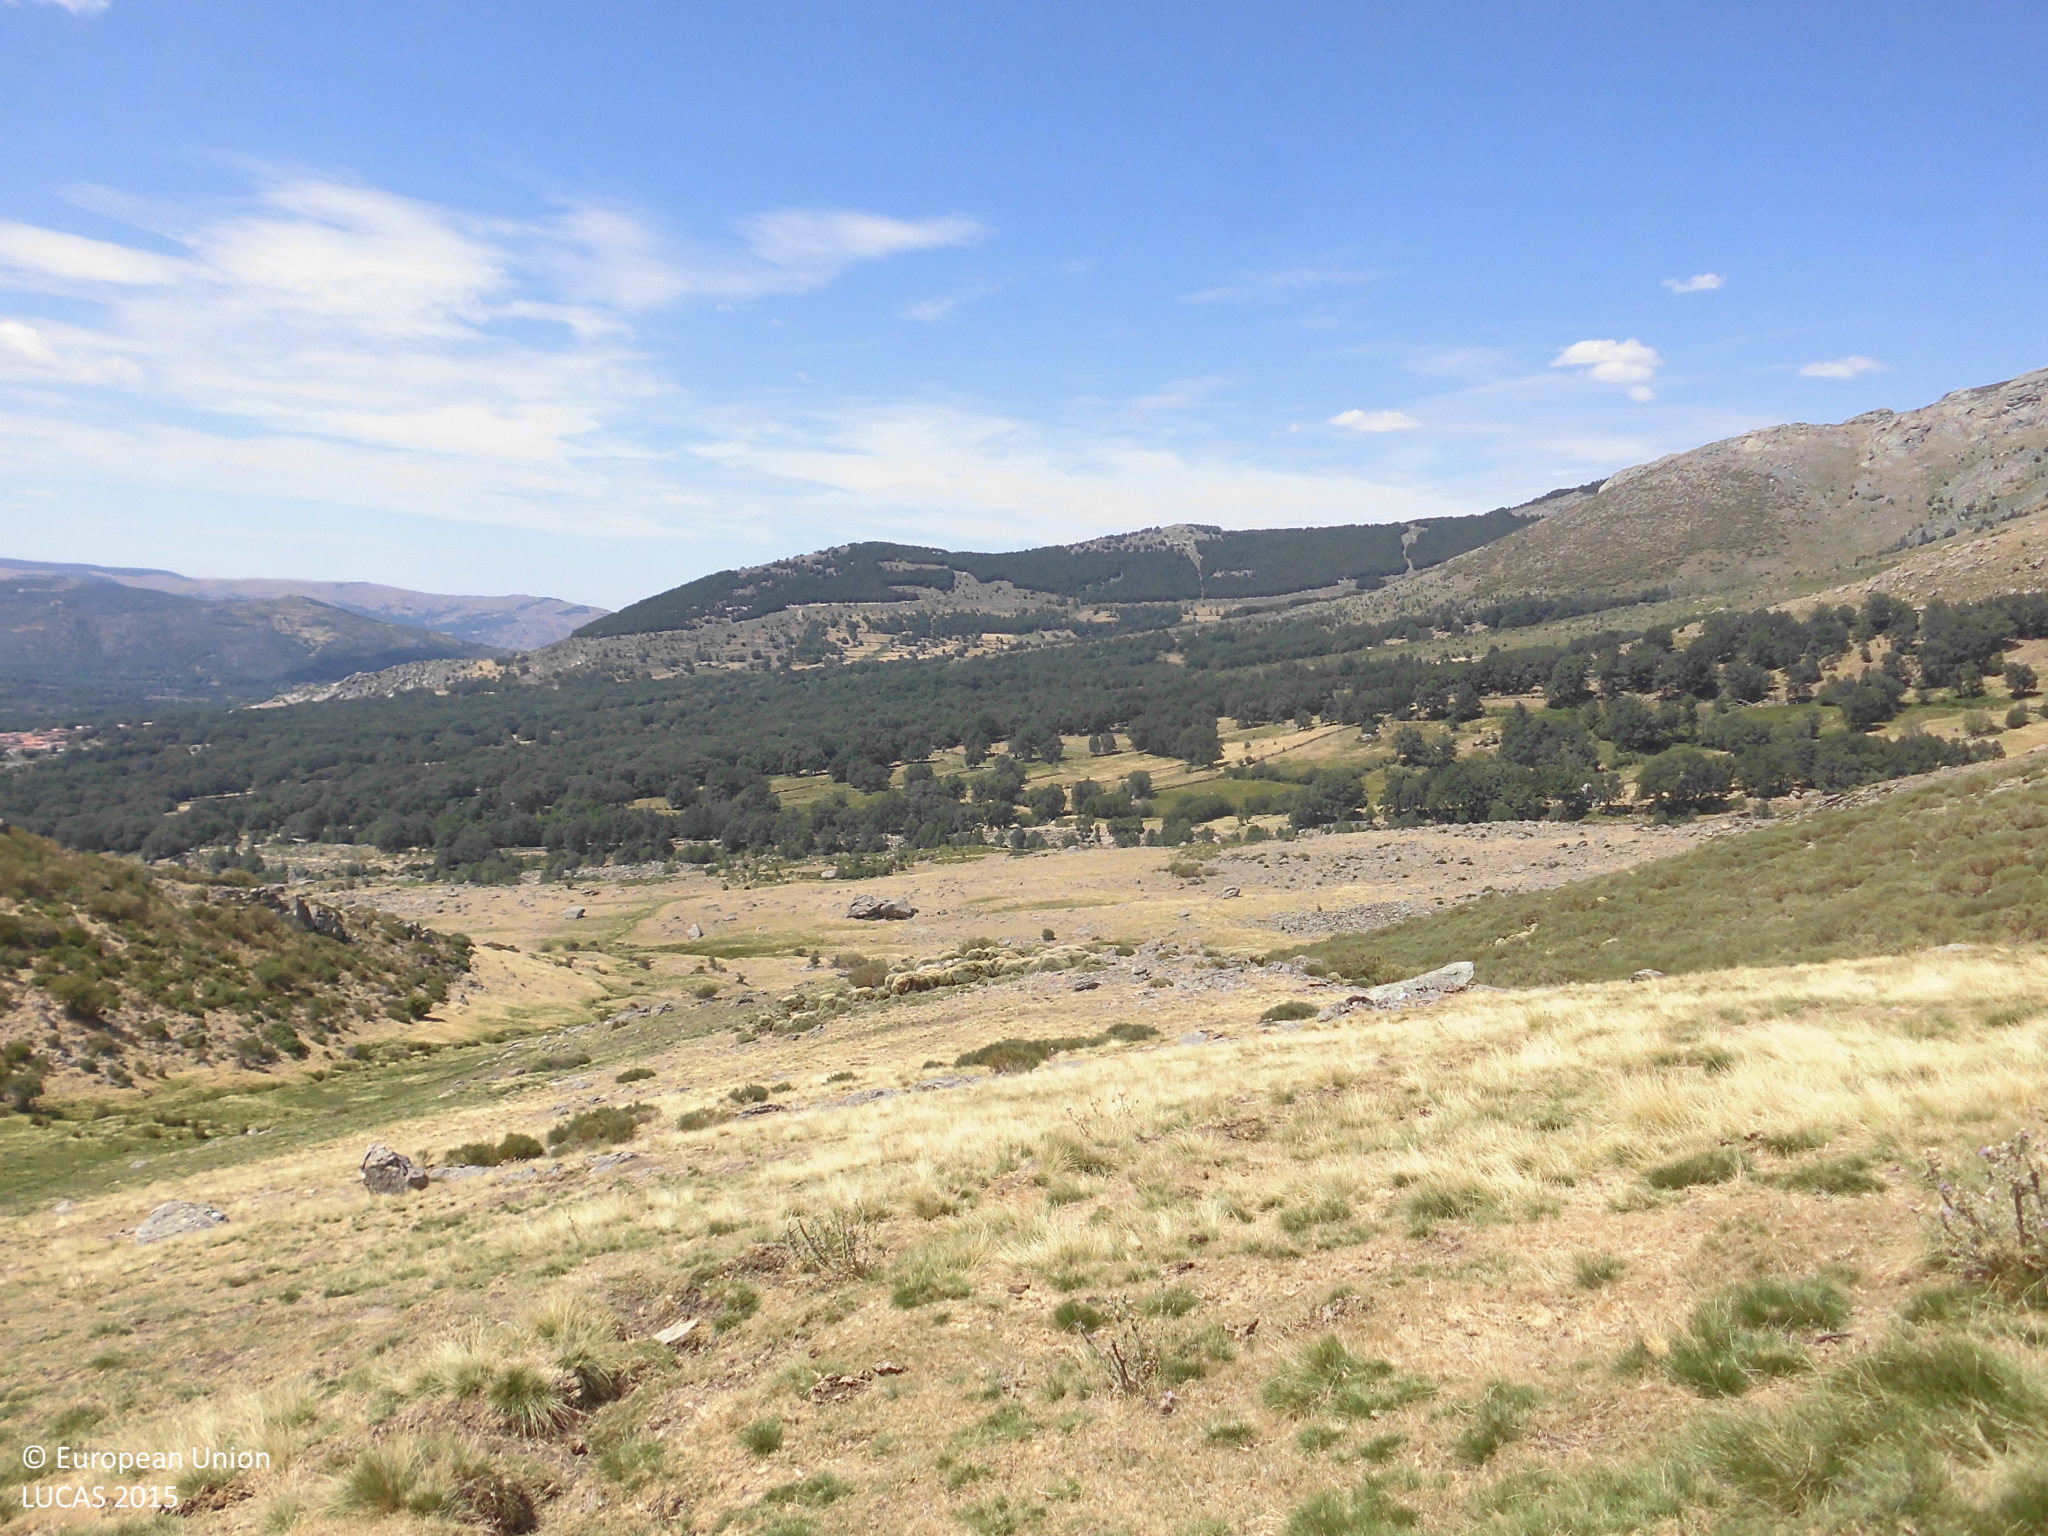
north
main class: Grassland
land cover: Grassland without tree/shrub cover
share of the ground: > 75 %
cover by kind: herbaceous plants 100 %
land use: Agriculture (excluding fallow land and kitchen gardens)
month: July
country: ES
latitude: 40.2620
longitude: -5.4786
